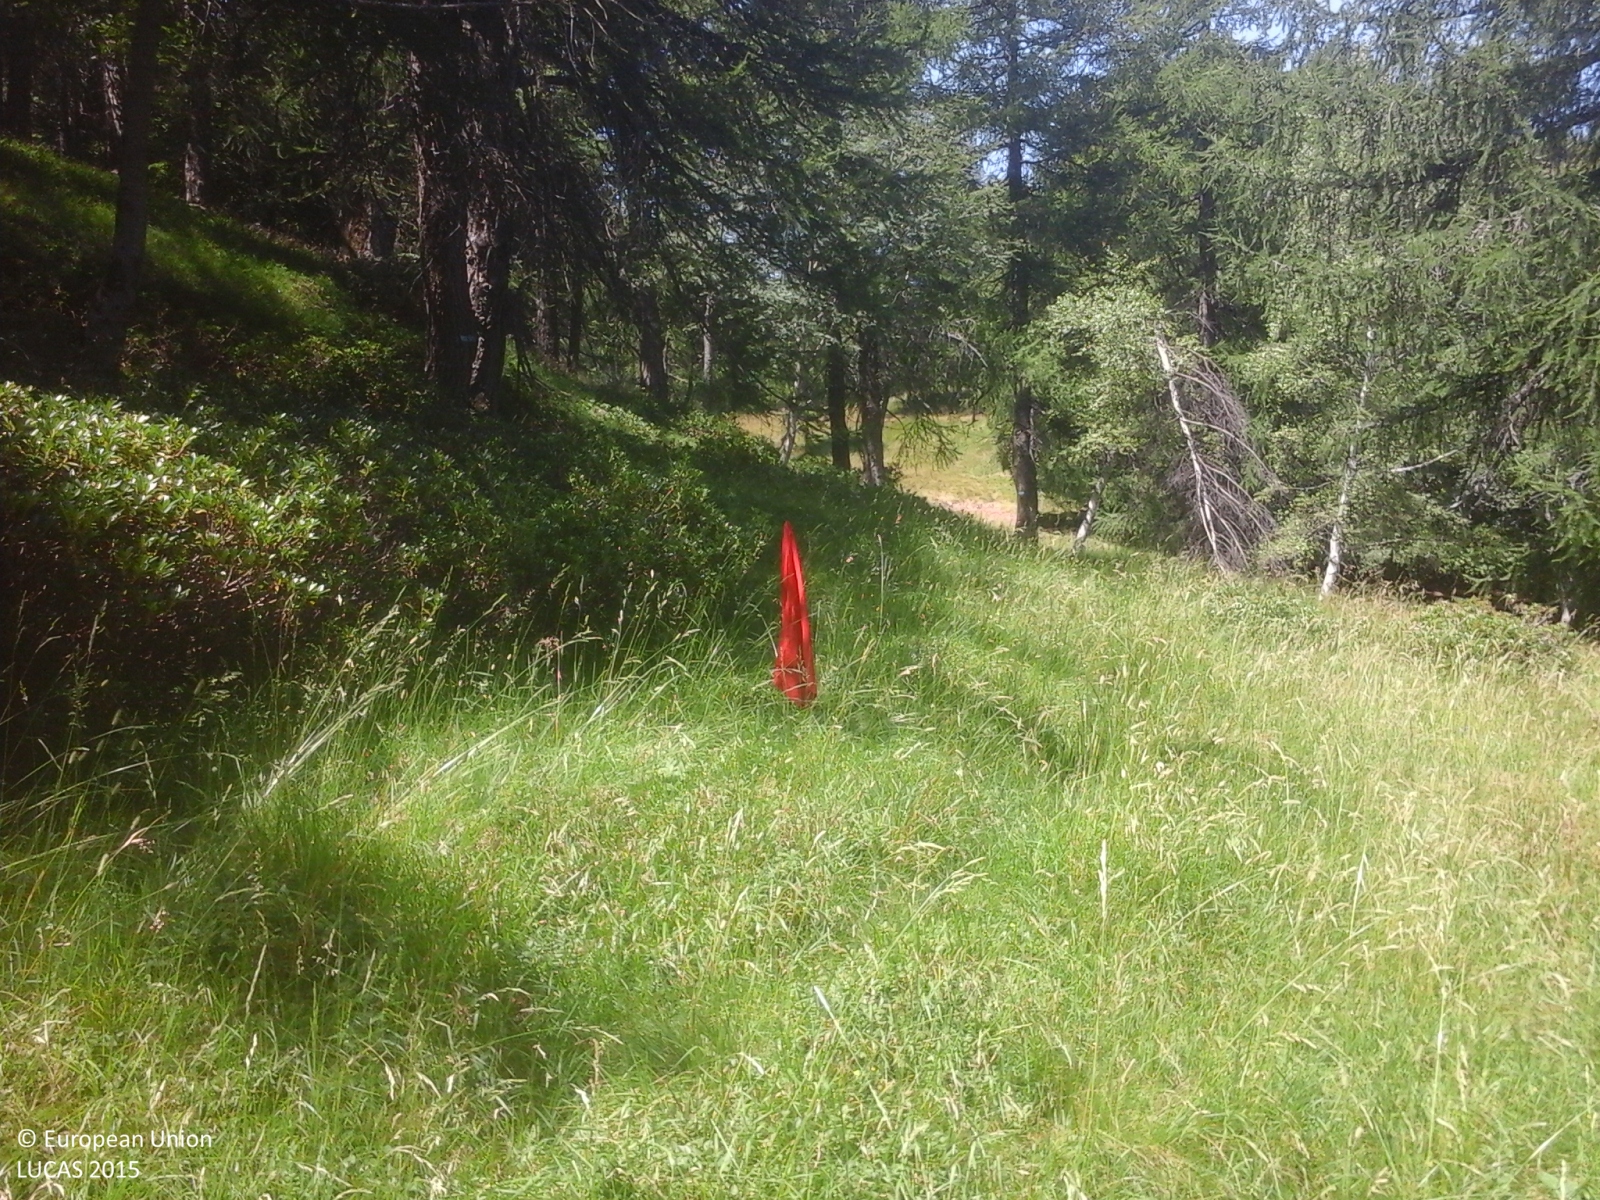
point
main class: Woodland
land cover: Spruce dominated mixed woodland
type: alpine coniferous forest
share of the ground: > 75 %
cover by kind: coniferous forest trees 65 %, broadleaved forest trees 25 %, herbaceous plants 10 %
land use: Forestry
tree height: > 5 m
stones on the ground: < 10 %
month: July
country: IT
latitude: 46.0971
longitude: 9.3671
